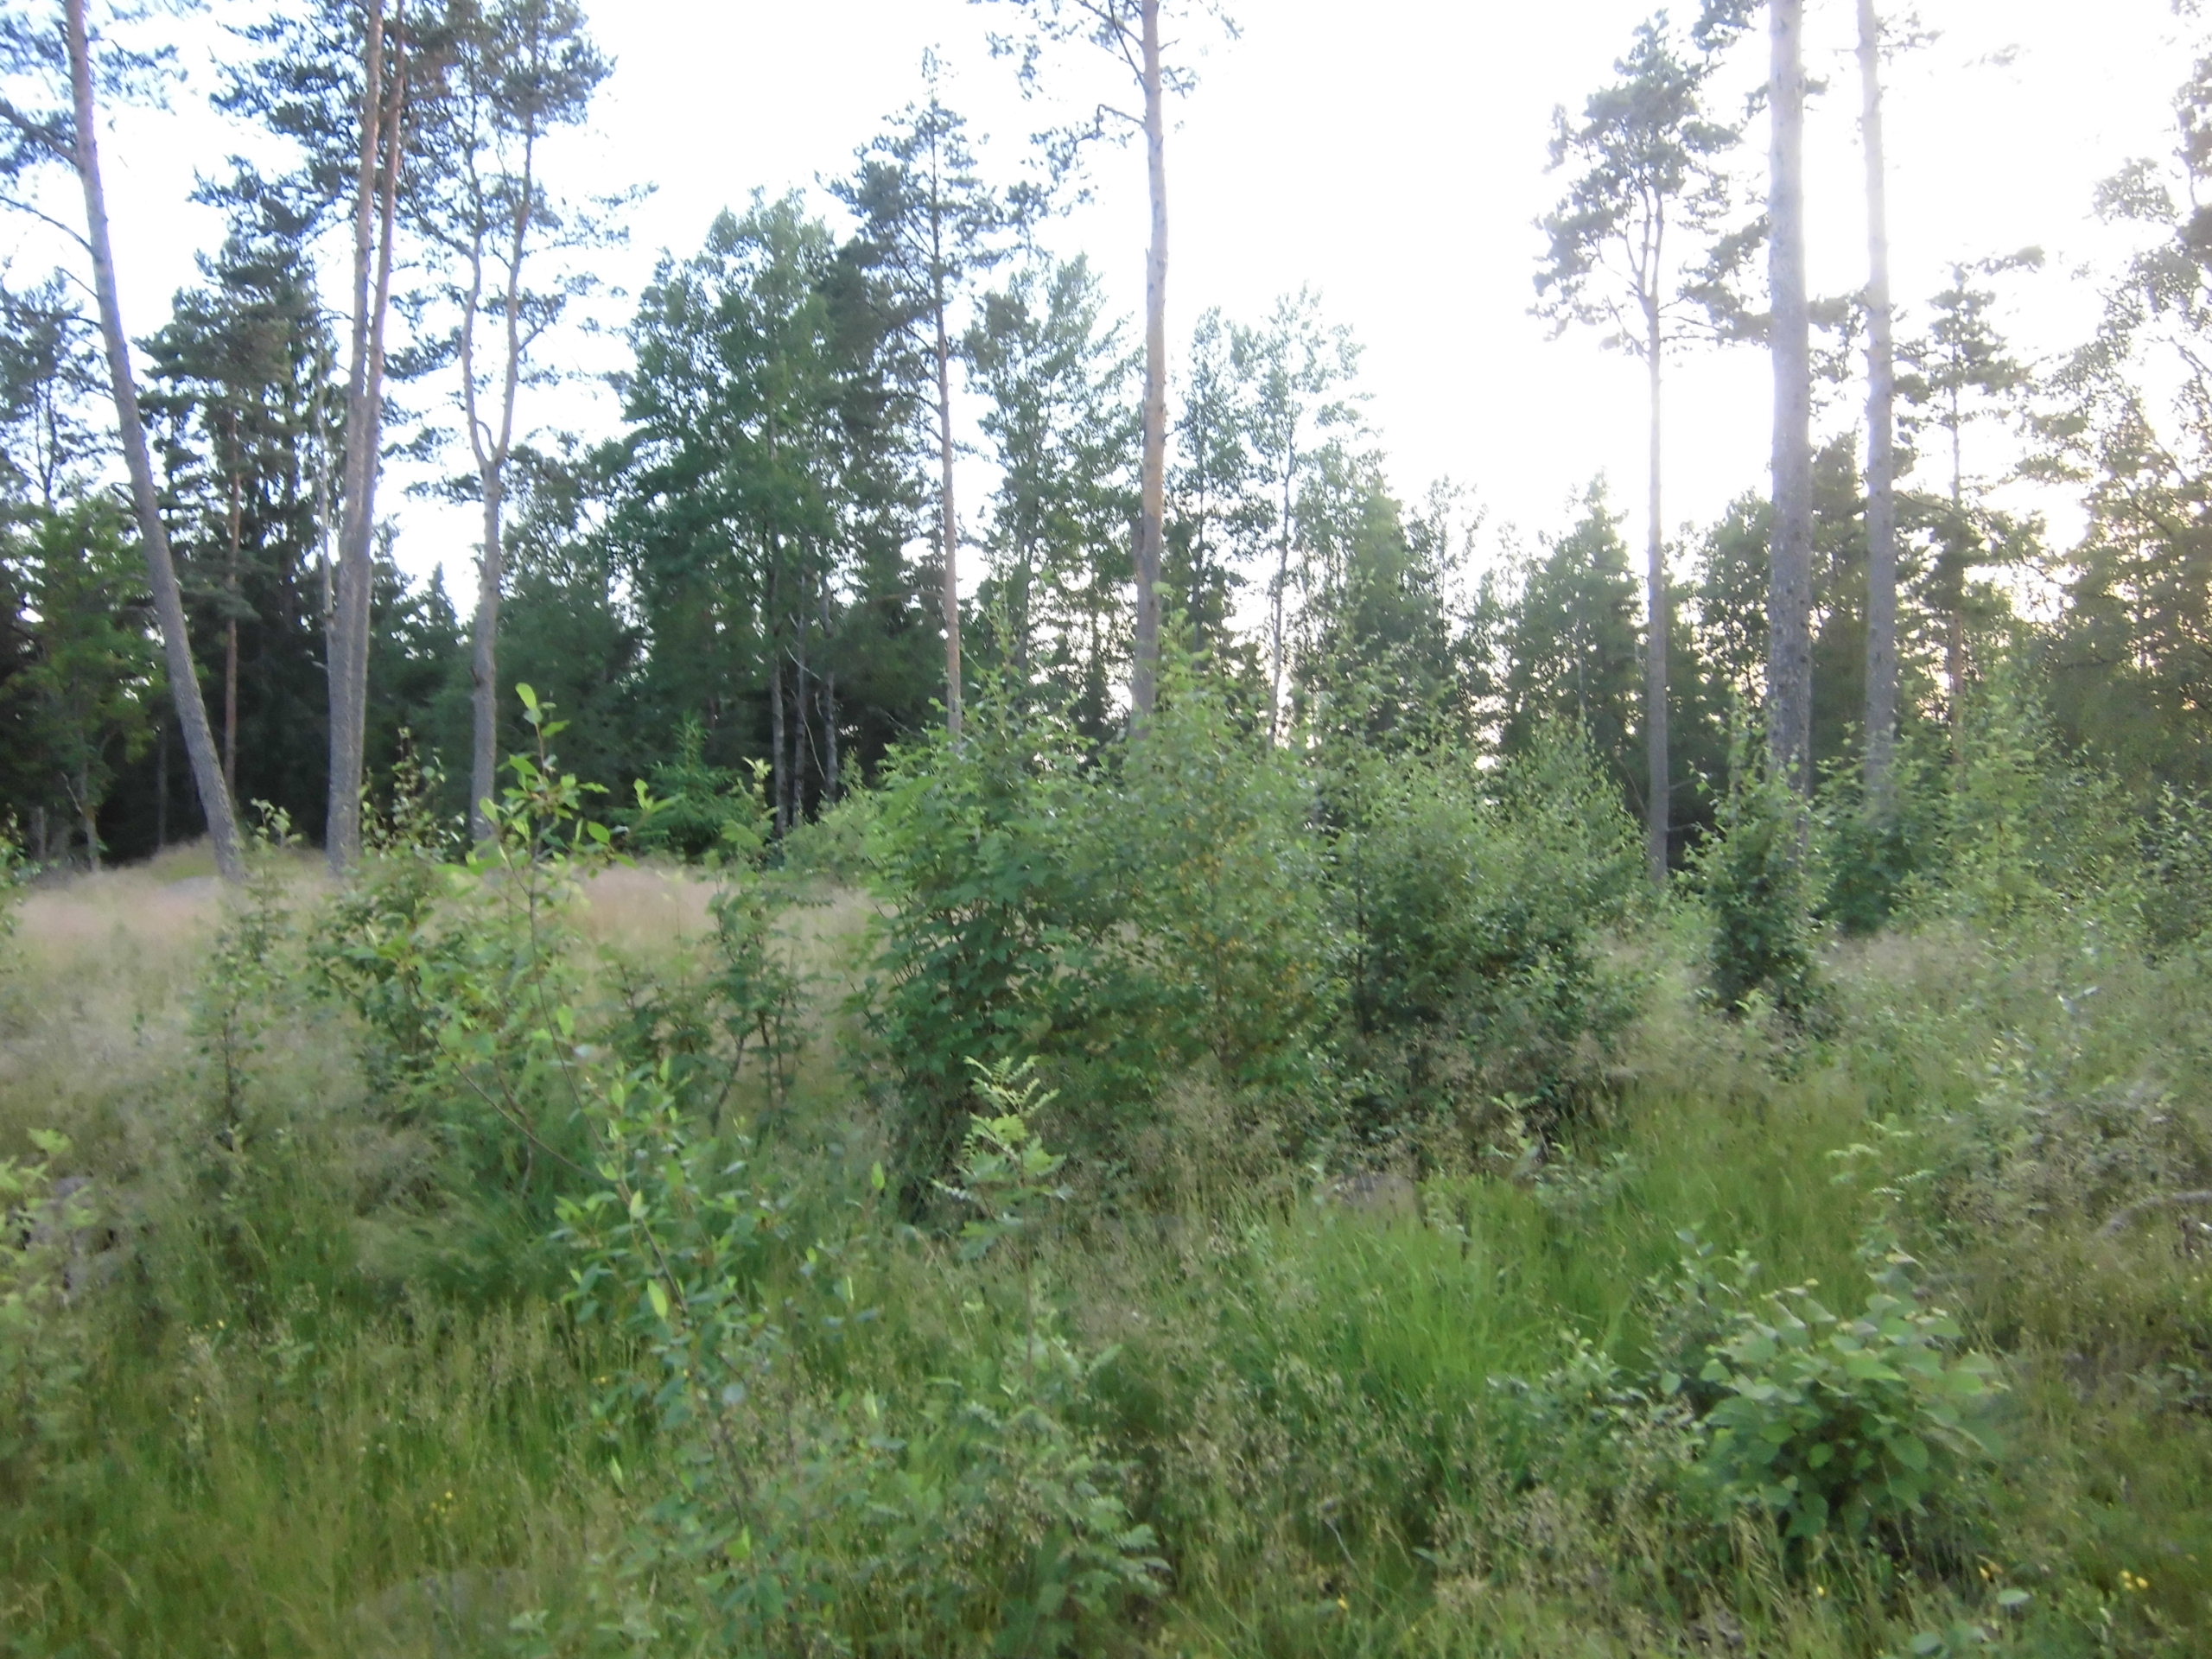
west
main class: Woodland
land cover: Broadleaved woodland
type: hemiboreal forest and nemoral coniferous forest and mixed broadleaved-coniferous forest
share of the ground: 50 - 75 %
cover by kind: broadleaved forest trees 50 %, herbaceous plants 30 %, shrubs 10 %, coniferous forest trees 5 %, lichens and mosses 5 %
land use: Forestry
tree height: > 5 m
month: July
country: SE
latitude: 57.2861
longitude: 14.8241
